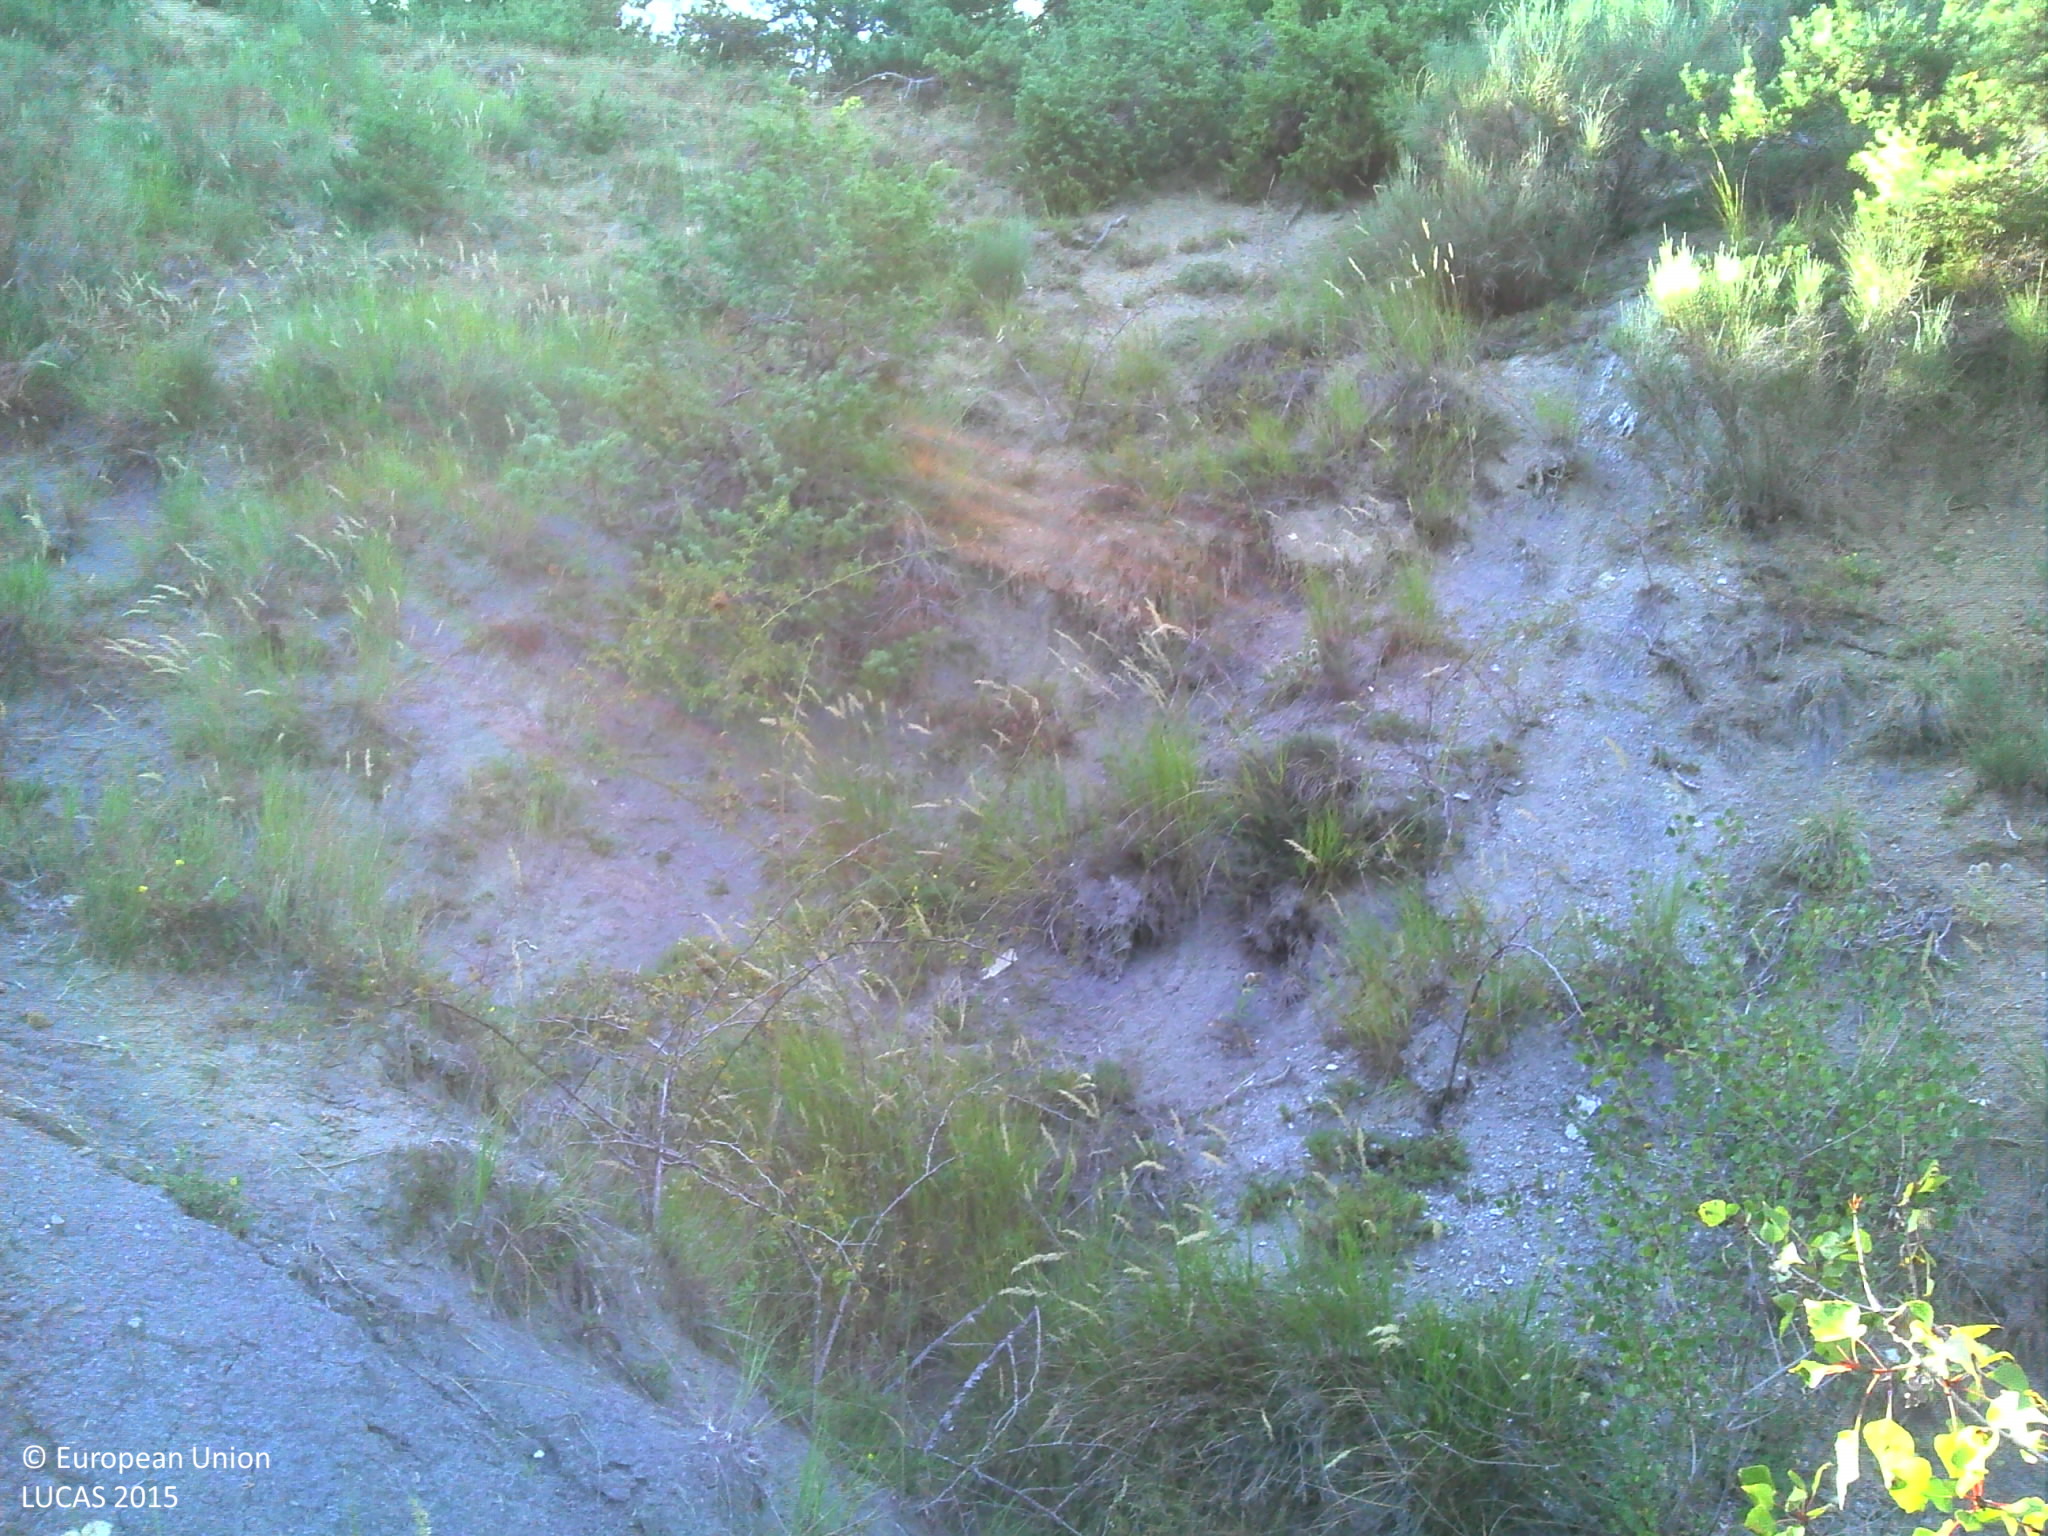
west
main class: Shrubland
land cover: Shrubland with sparse tree cover
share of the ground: > 75 %
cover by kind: shrubs 65 %, unconsolidated bare surface 20 %, consolidated bare surface 10 %, coniferous forest trees 5 %
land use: Semi-natural and natural areas not in use
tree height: < 5 m
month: September
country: FR
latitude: 44.4977
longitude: 5.3160
